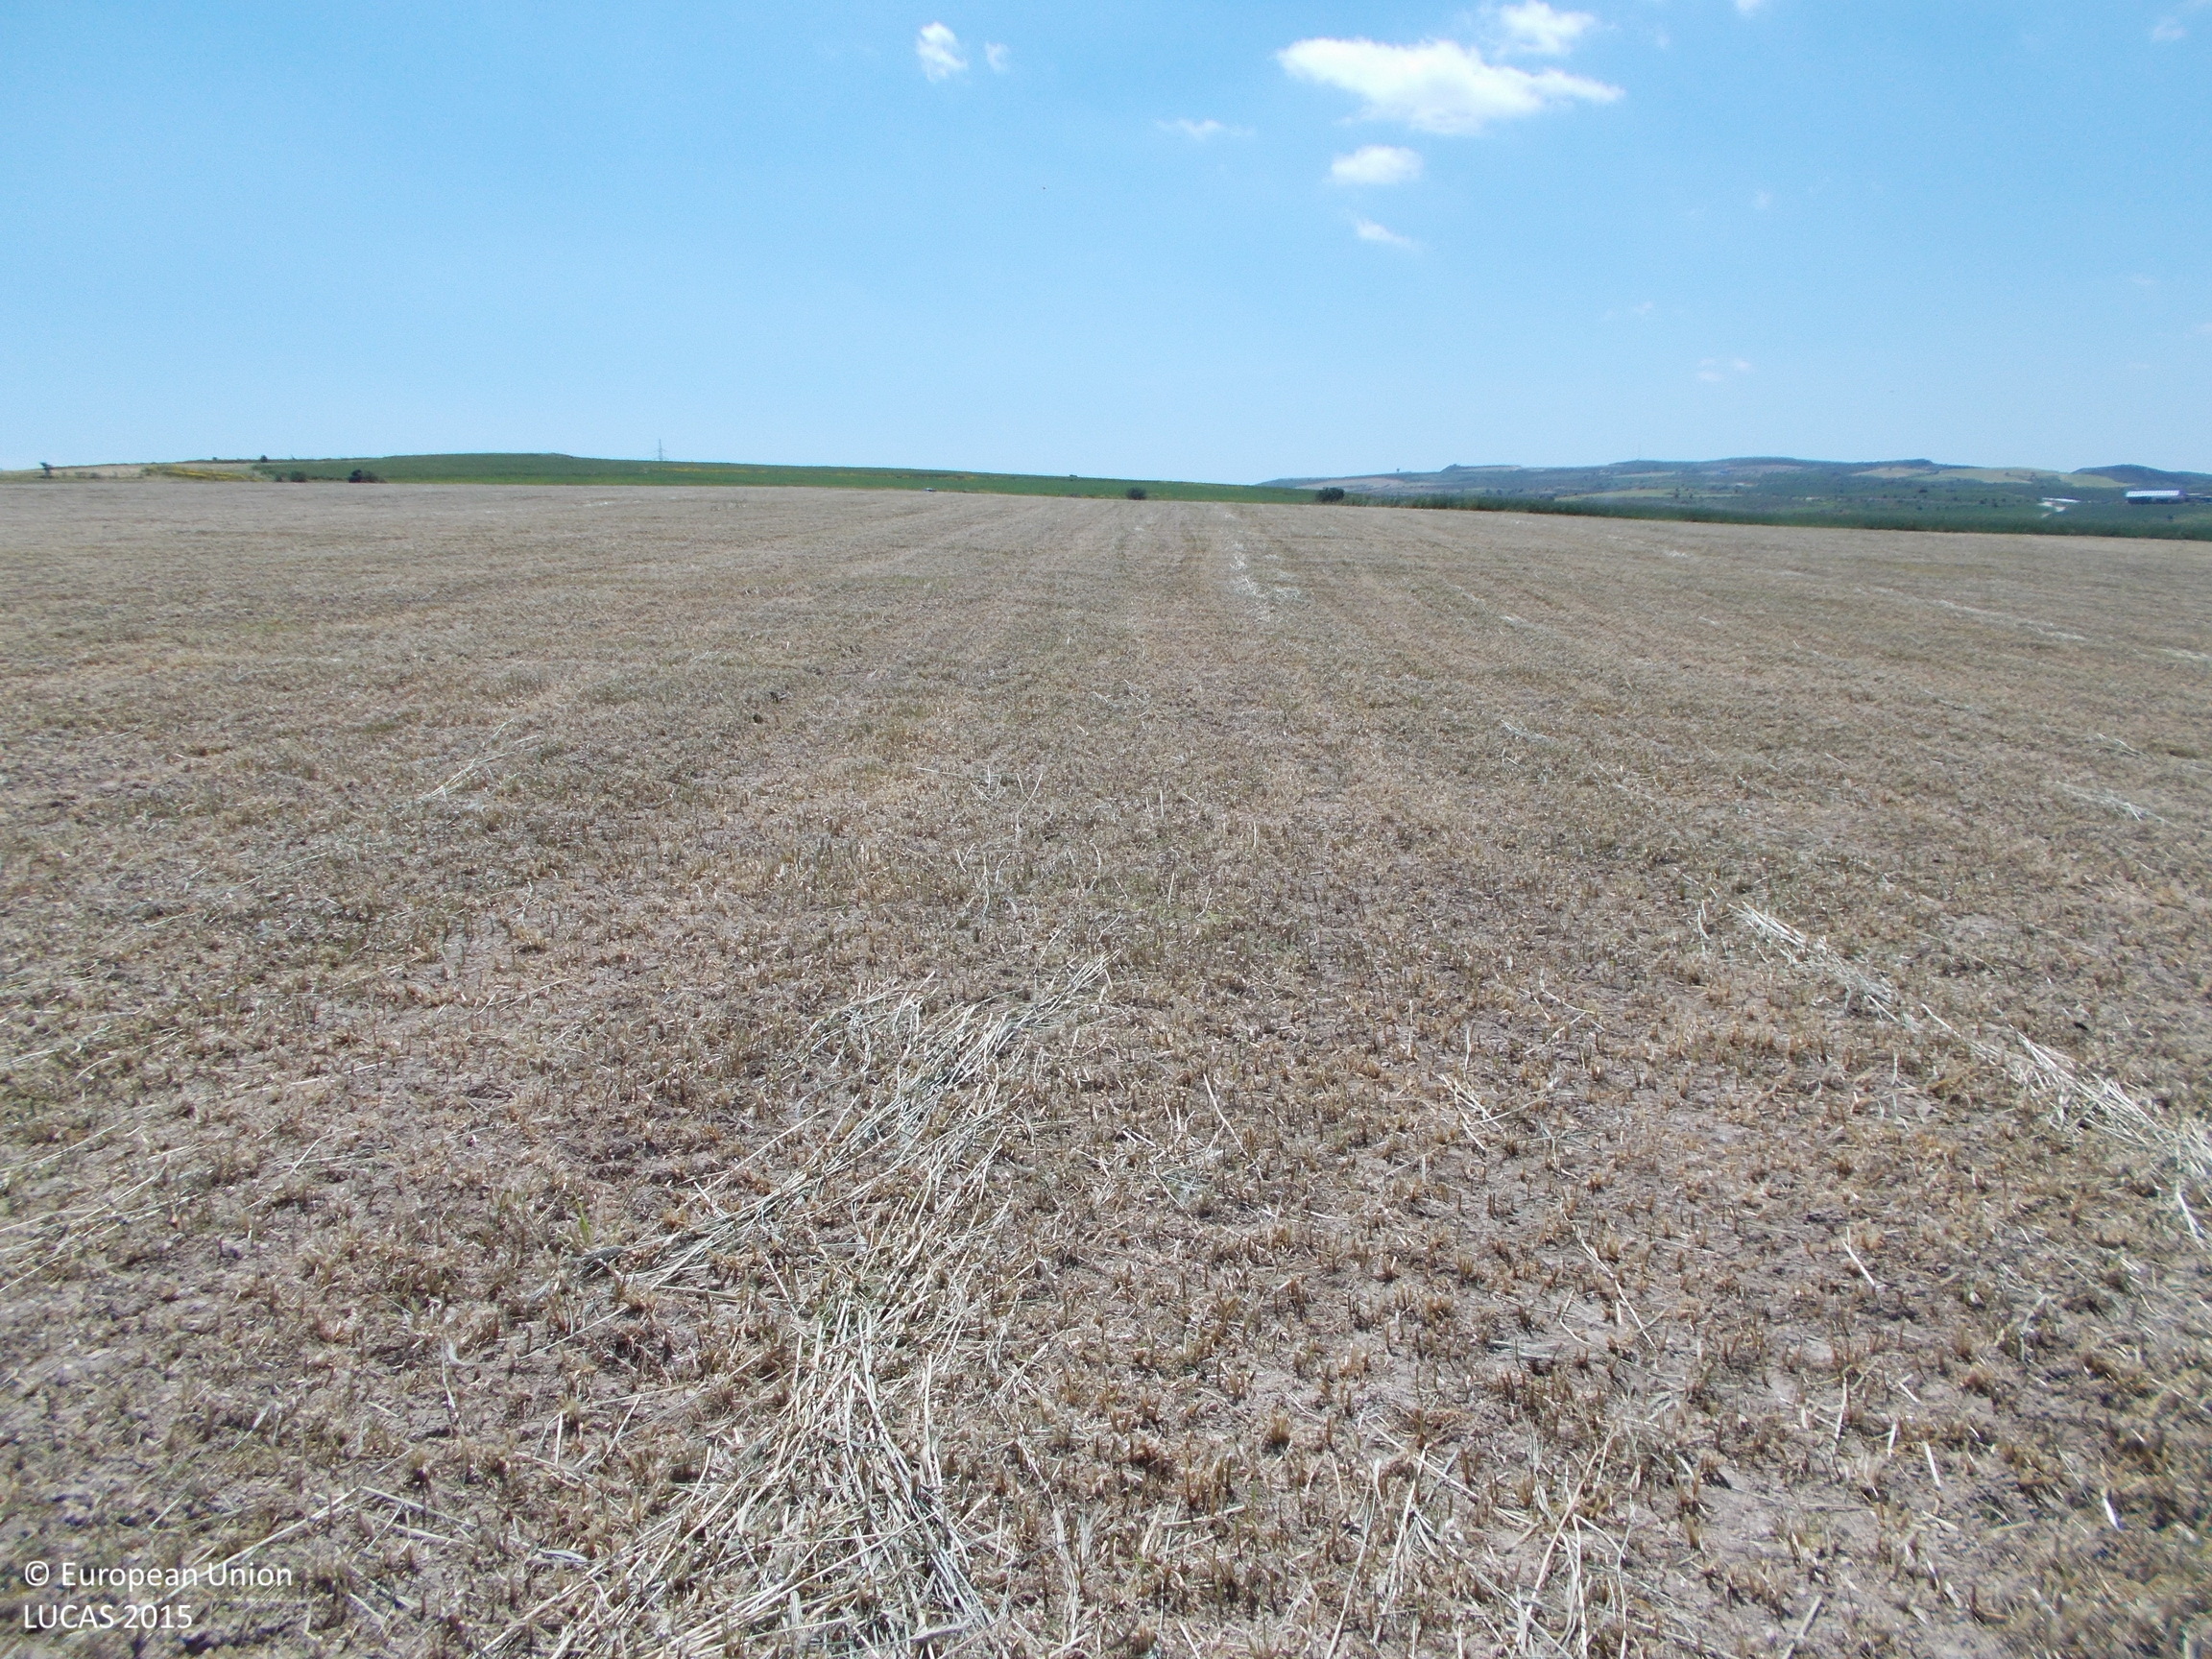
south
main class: Cropland
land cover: Barley
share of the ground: < 10 %
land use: Agriculture (excluding fallow land and kitchen gardens)
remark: Harvested field
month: April
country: CY
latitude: 35.0434
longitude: 33.5591
